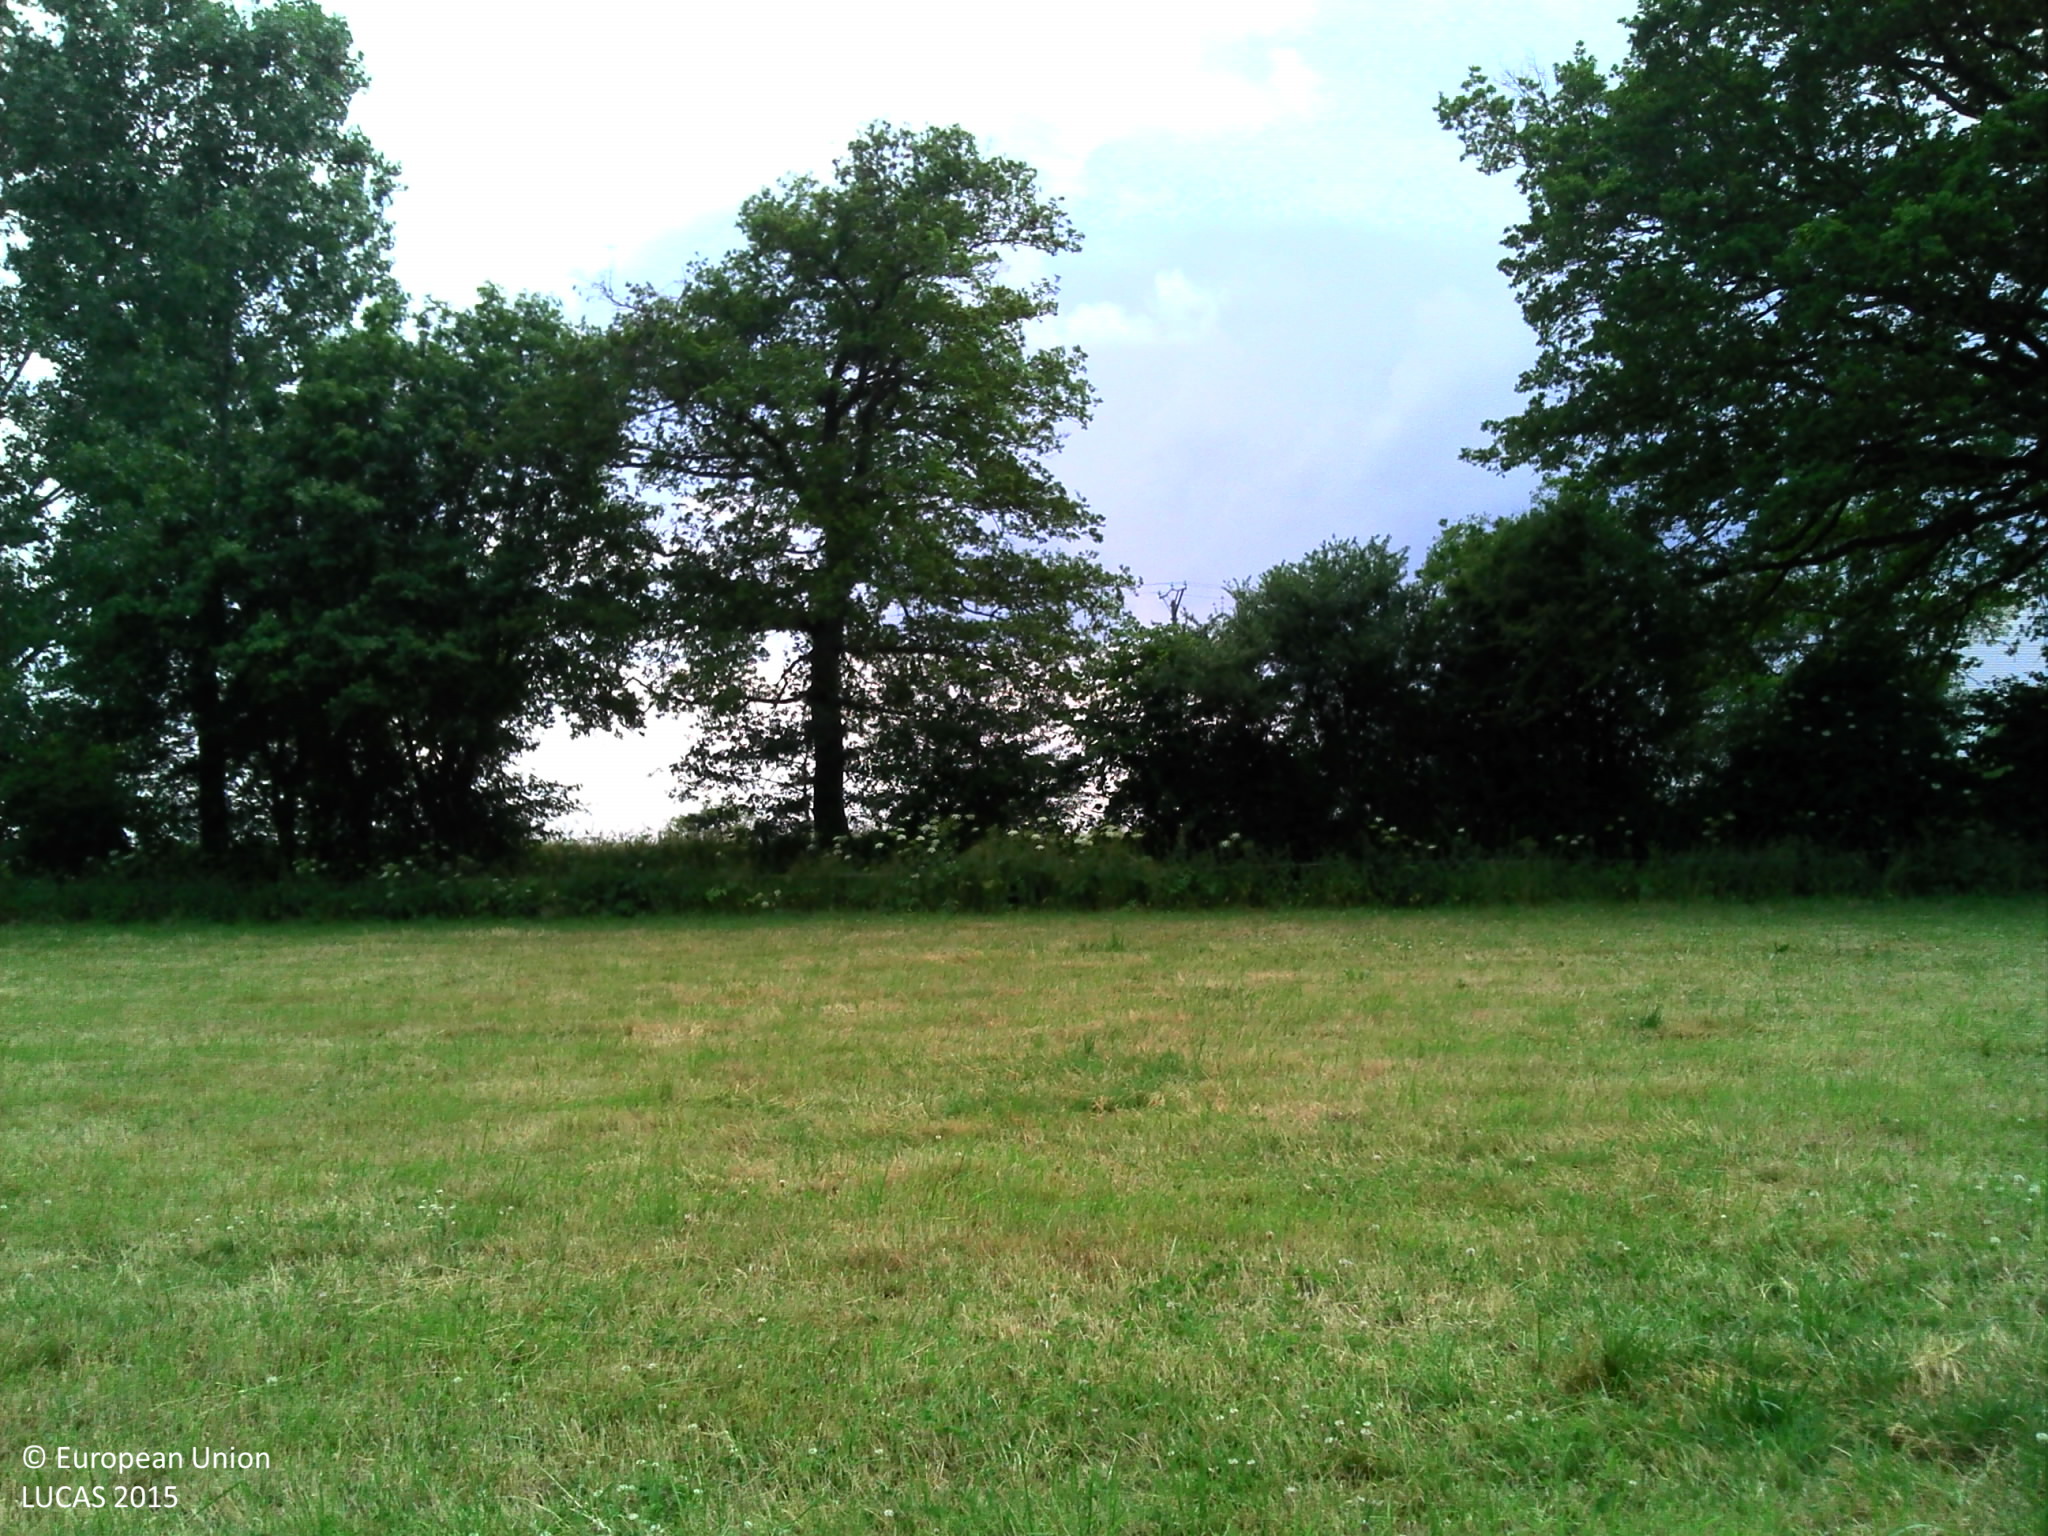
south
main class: Cropland
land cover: Temporary grasslands
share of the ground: > 75 %
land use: Agriculture (excluding fallow land and kitchen gardens)
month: June
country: FR
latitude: 46.3204
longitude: 2.9974
